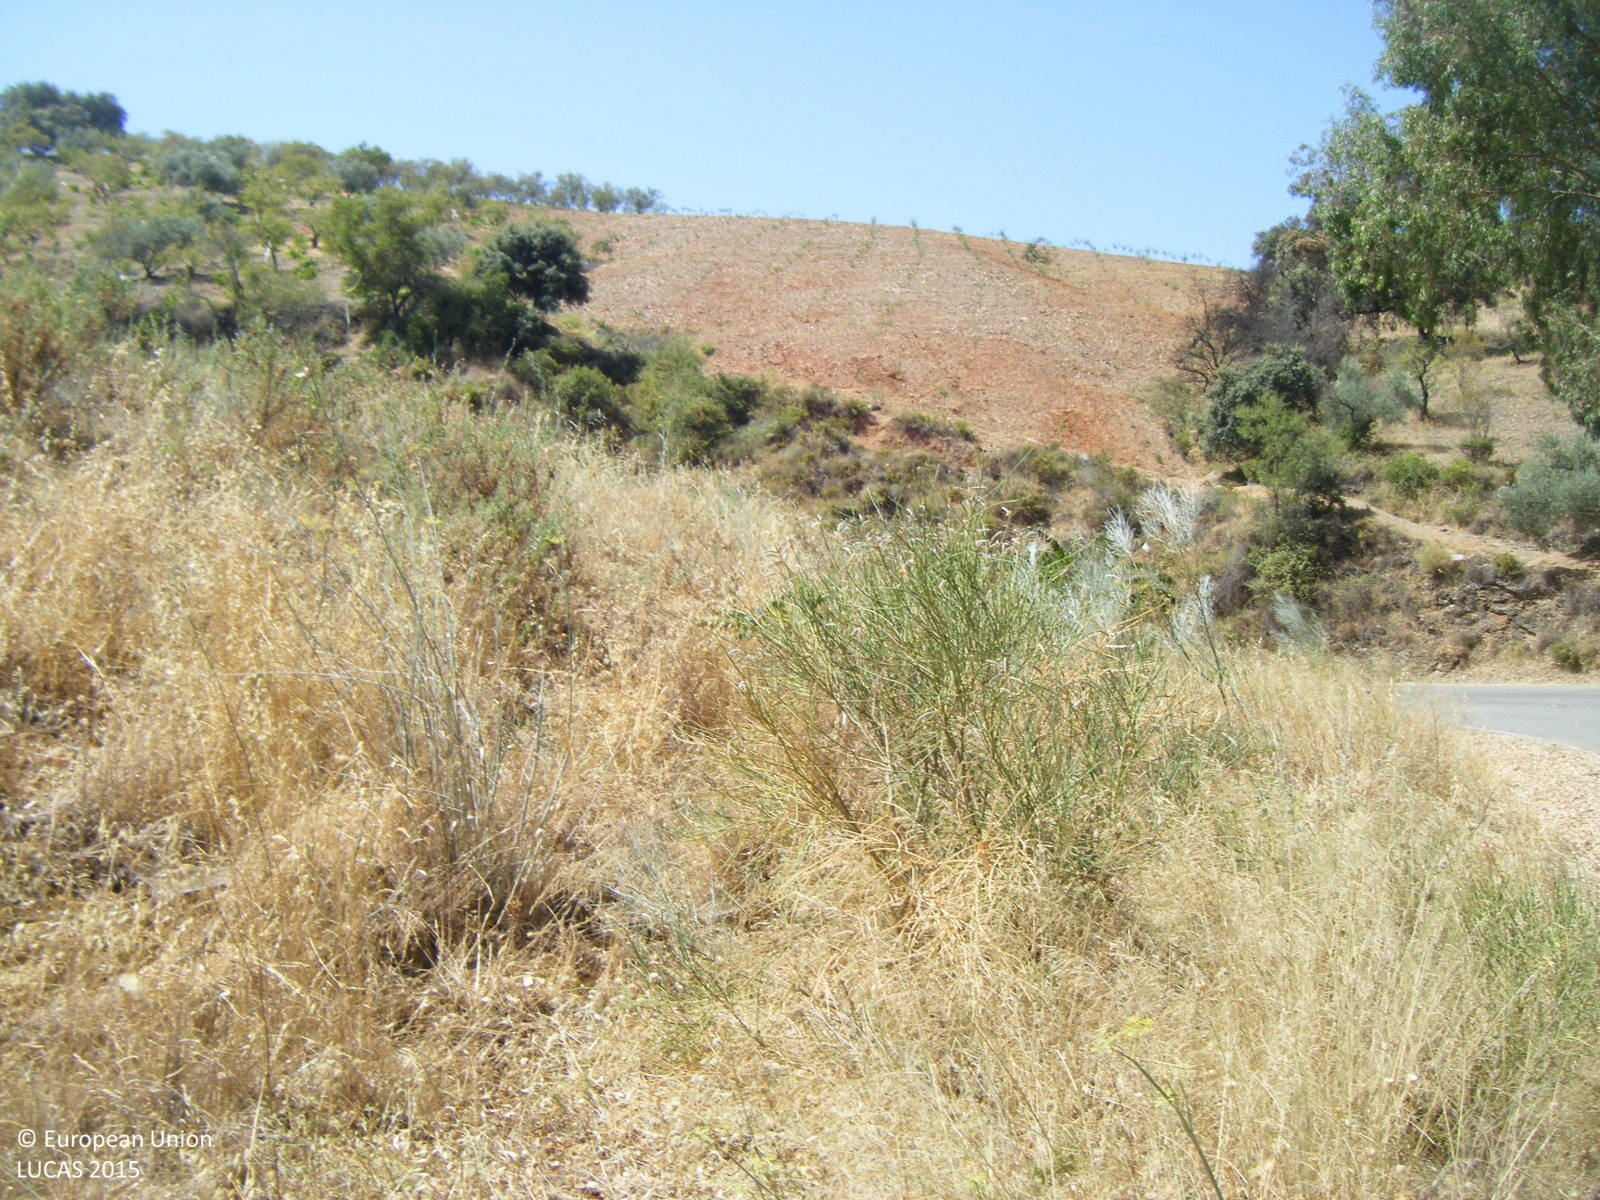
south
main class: Grassland
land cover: Grassland without tree/shrub cover
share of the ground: 50 - 75 %
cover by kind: herbaceous plants 70 %, unconsolidated bare surface 30 %
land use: Semi-natural and natural areas not in use
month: July
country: ES
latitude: 36.8930
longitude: -4.3441
